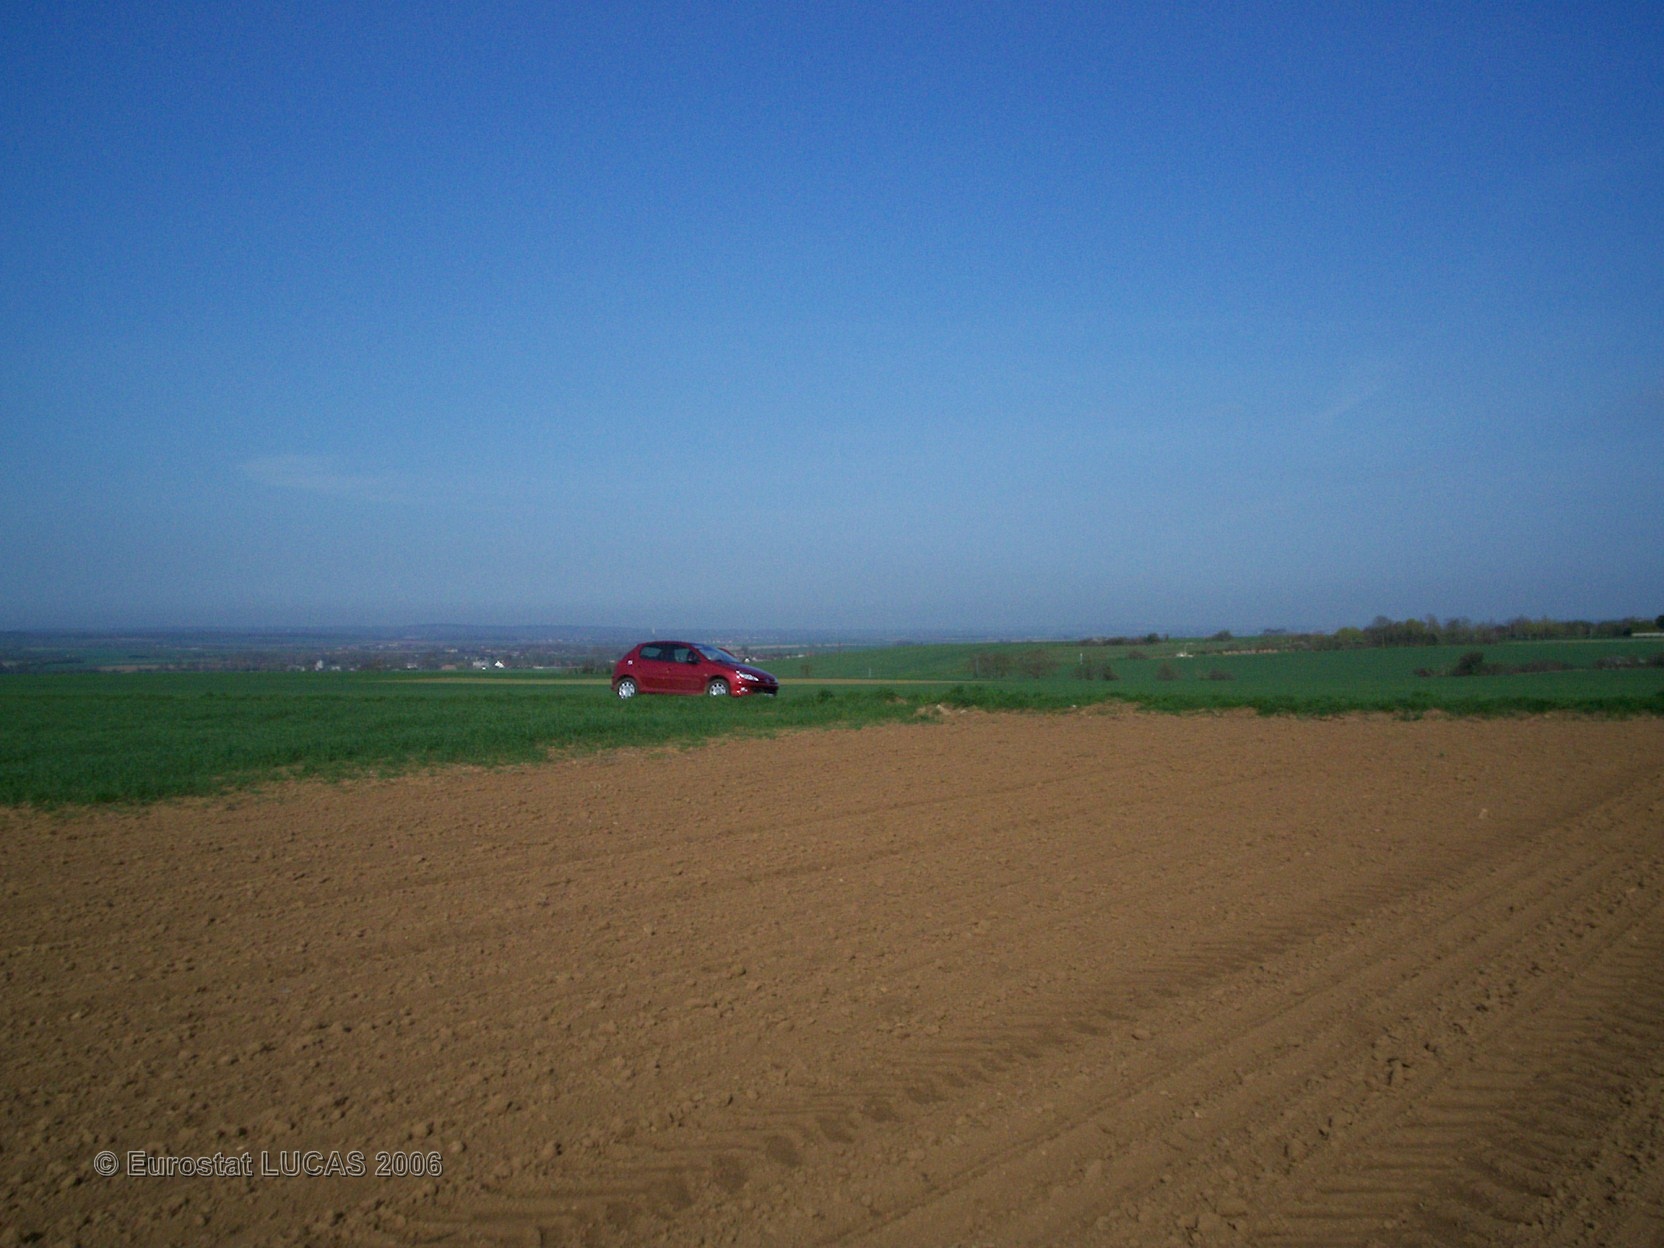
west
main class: Cropland
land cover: Other fibre and oleaginous crops
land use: Agriculture (excluding fallow land and kitchen gardens)
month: April
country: FR
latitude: 48.8585
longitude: 0.0335
